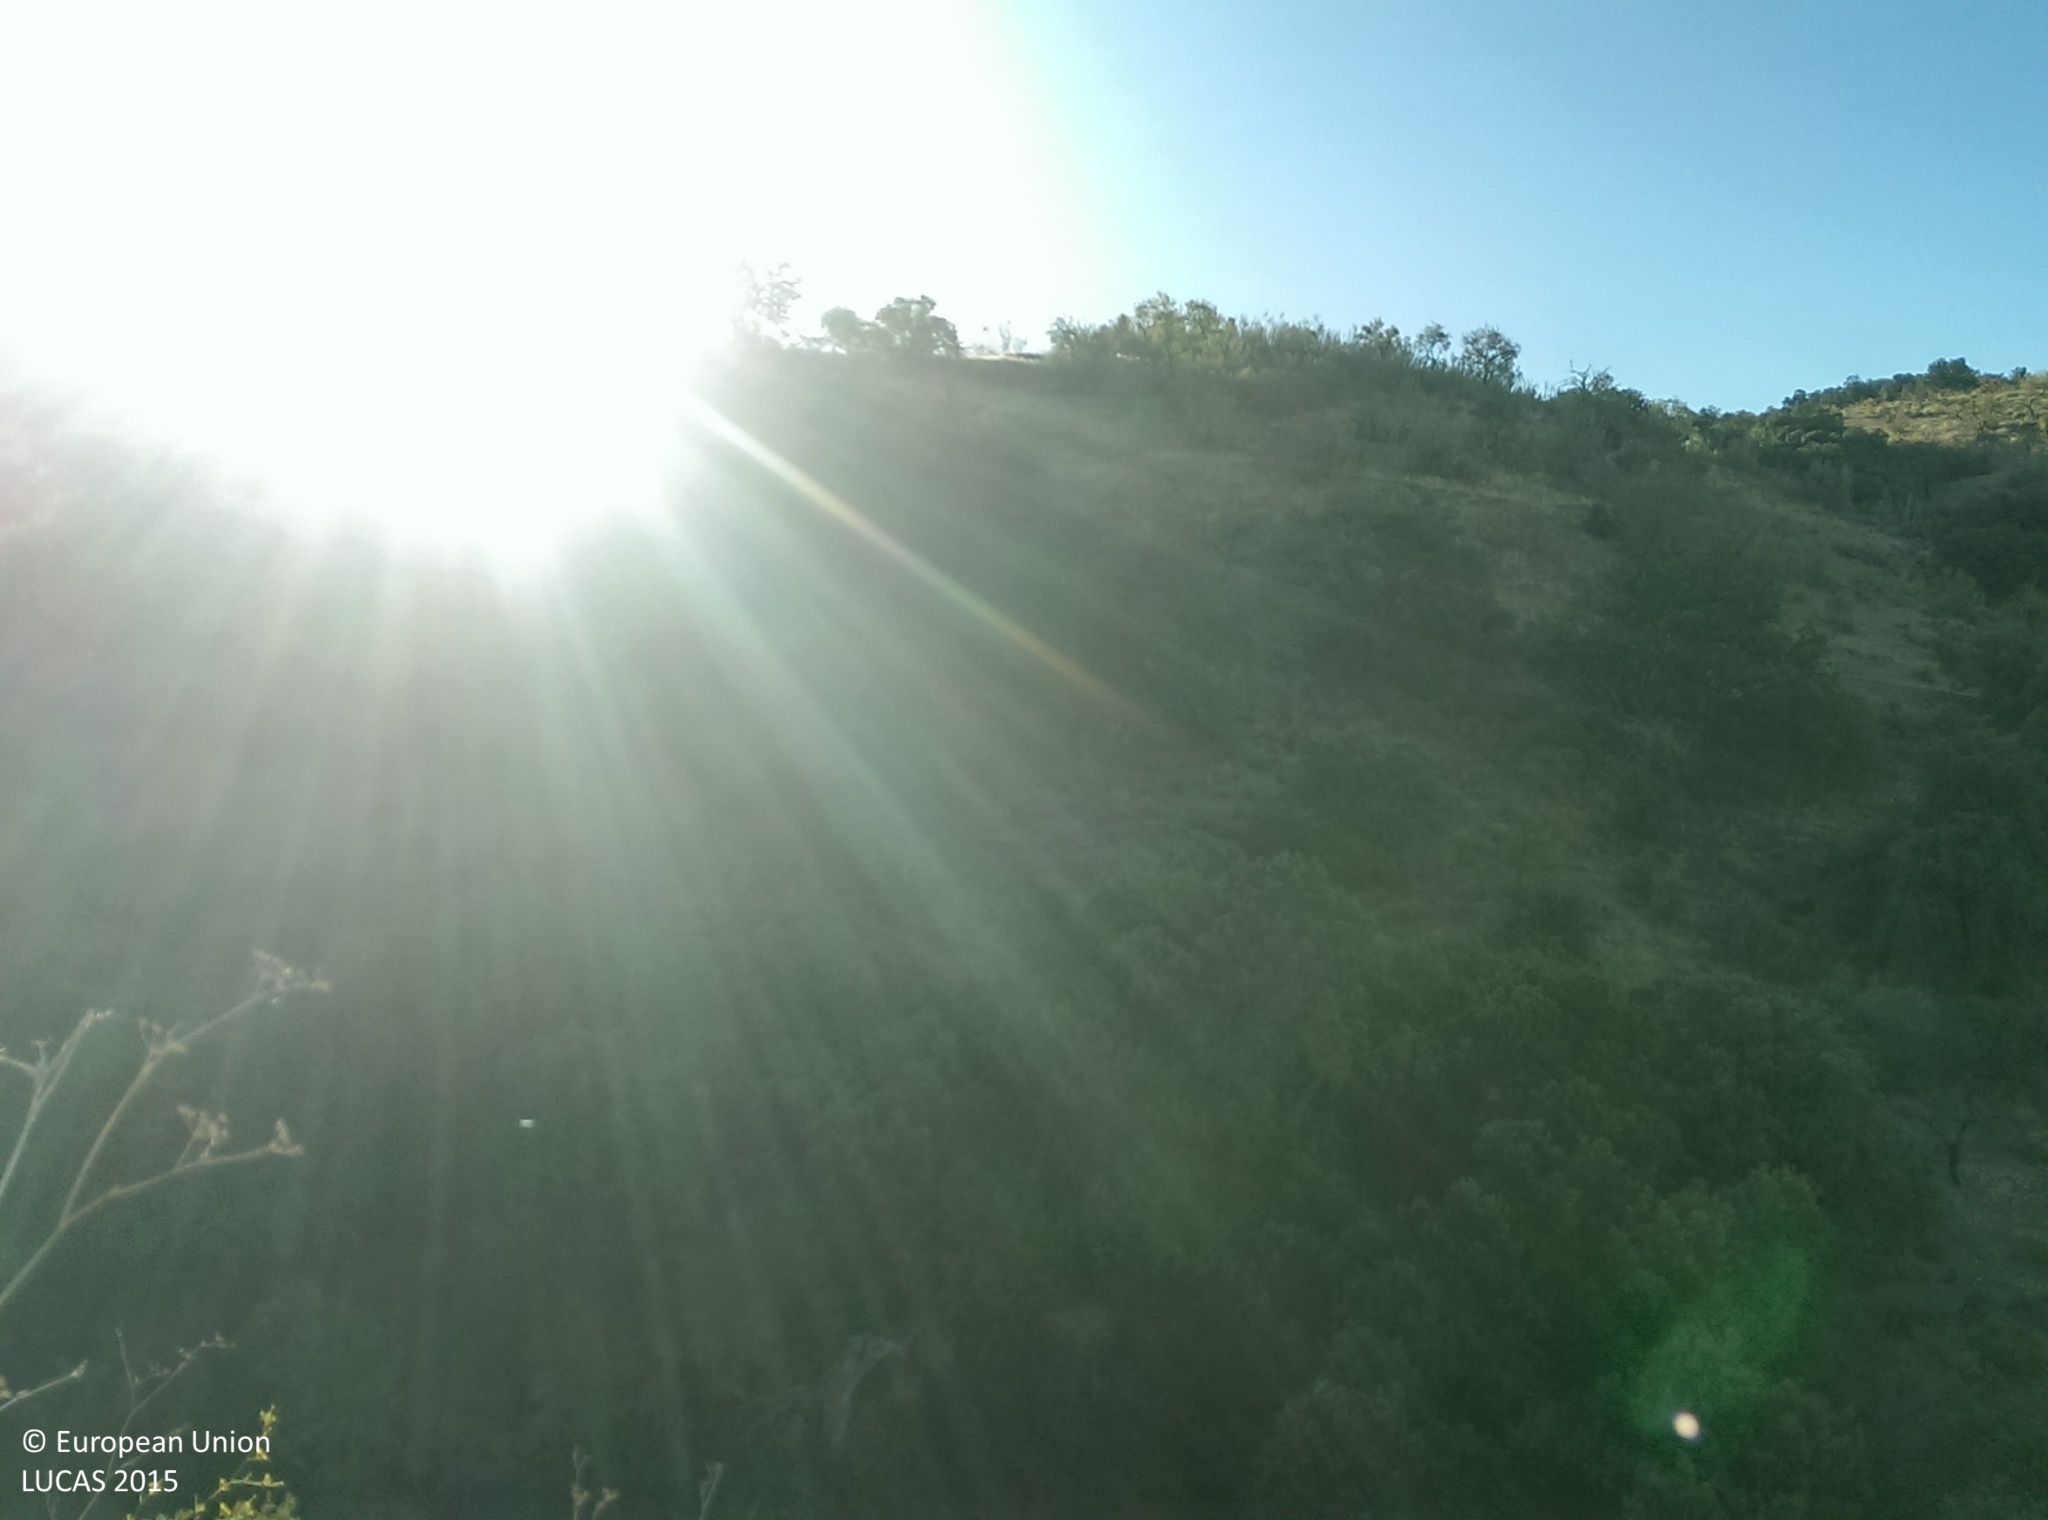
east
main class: Grassland
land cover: Grassland without tree/shrub cover
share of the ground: > 75 %
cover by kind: herbaceous plants 100 %
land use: Abandoned areas
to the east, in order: Grassland without tree/shrub cover; Broadleaved woodland; Rivers and streams; Broadleaved woodland; Nuts trees; Grassland with sparse tree/shrub cover; Rivers and streams; Broadleaved woodland
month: August
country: ES
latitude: 36.8862
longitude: -3.1420
